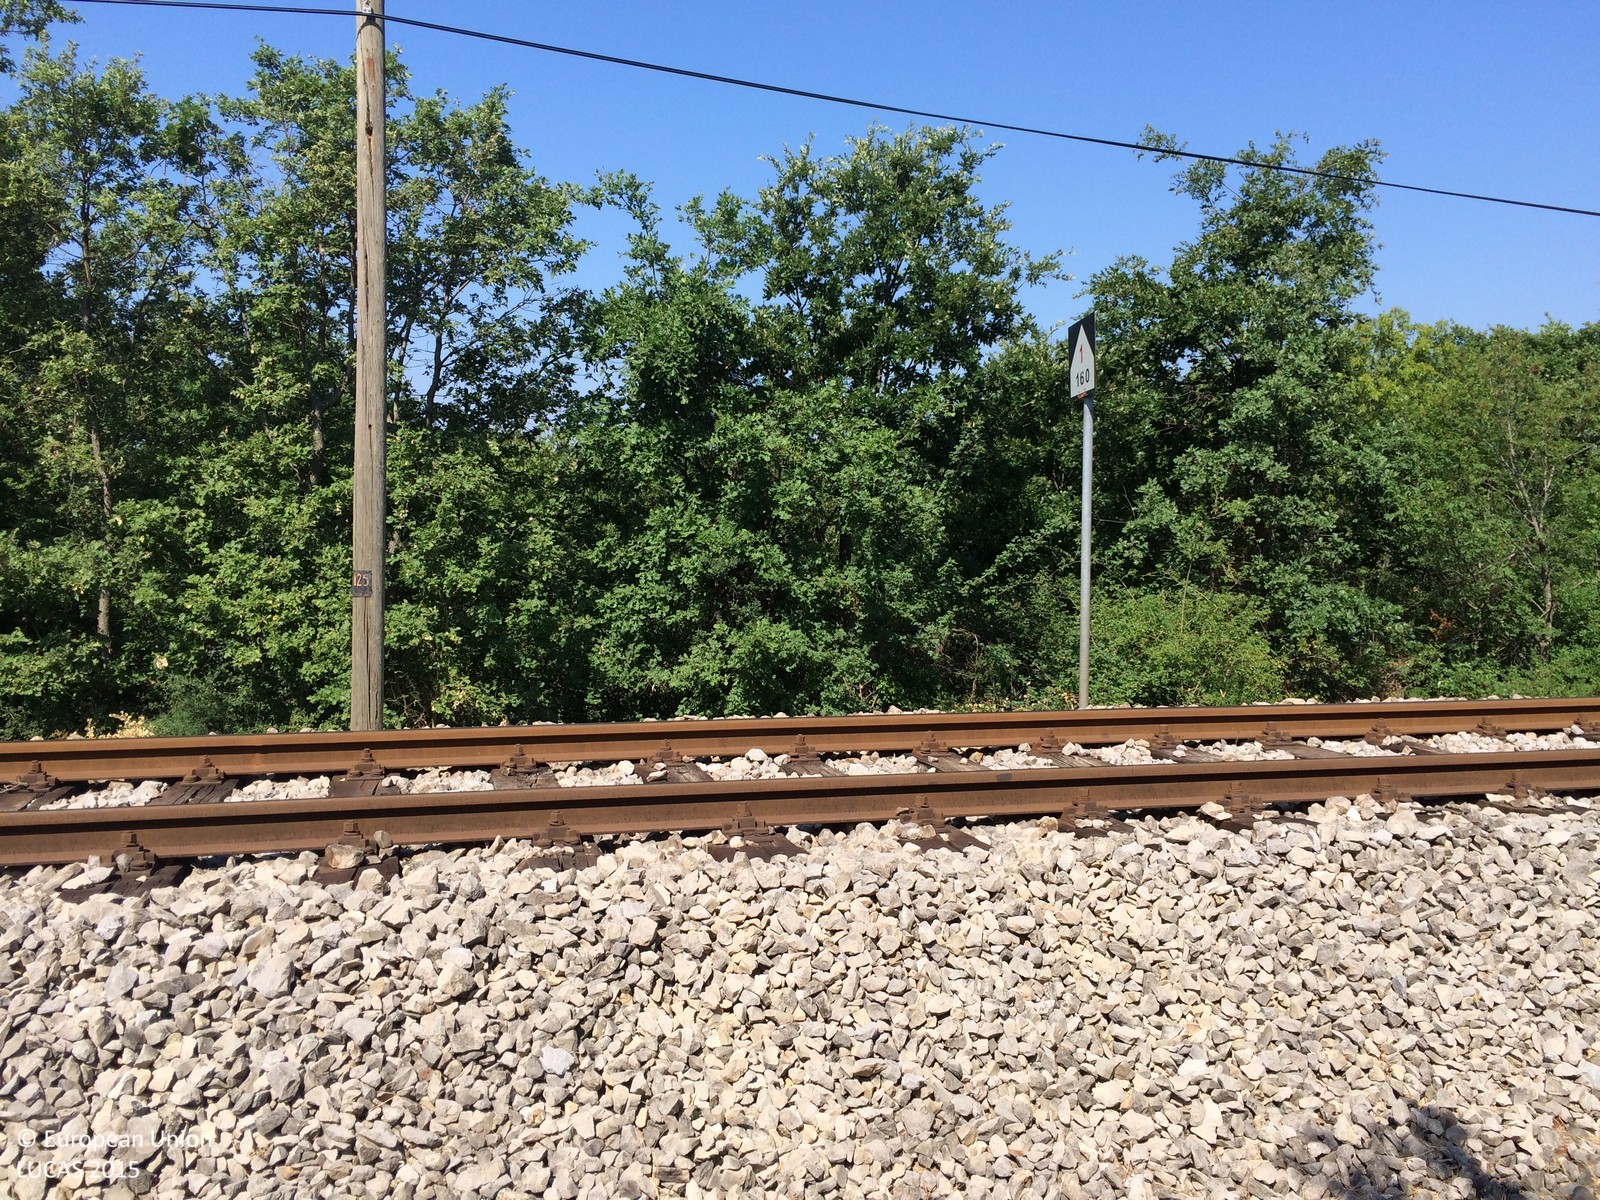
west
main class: Shrubland
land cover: Shrubland with sparse tree cover
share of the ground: < 10 %
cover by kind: shrubs 95 %, broadleaved forest trees 5 %
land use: Semi-natural and natural areas not in use
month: June
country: HR
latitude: 45.0007
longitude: 13.8636
